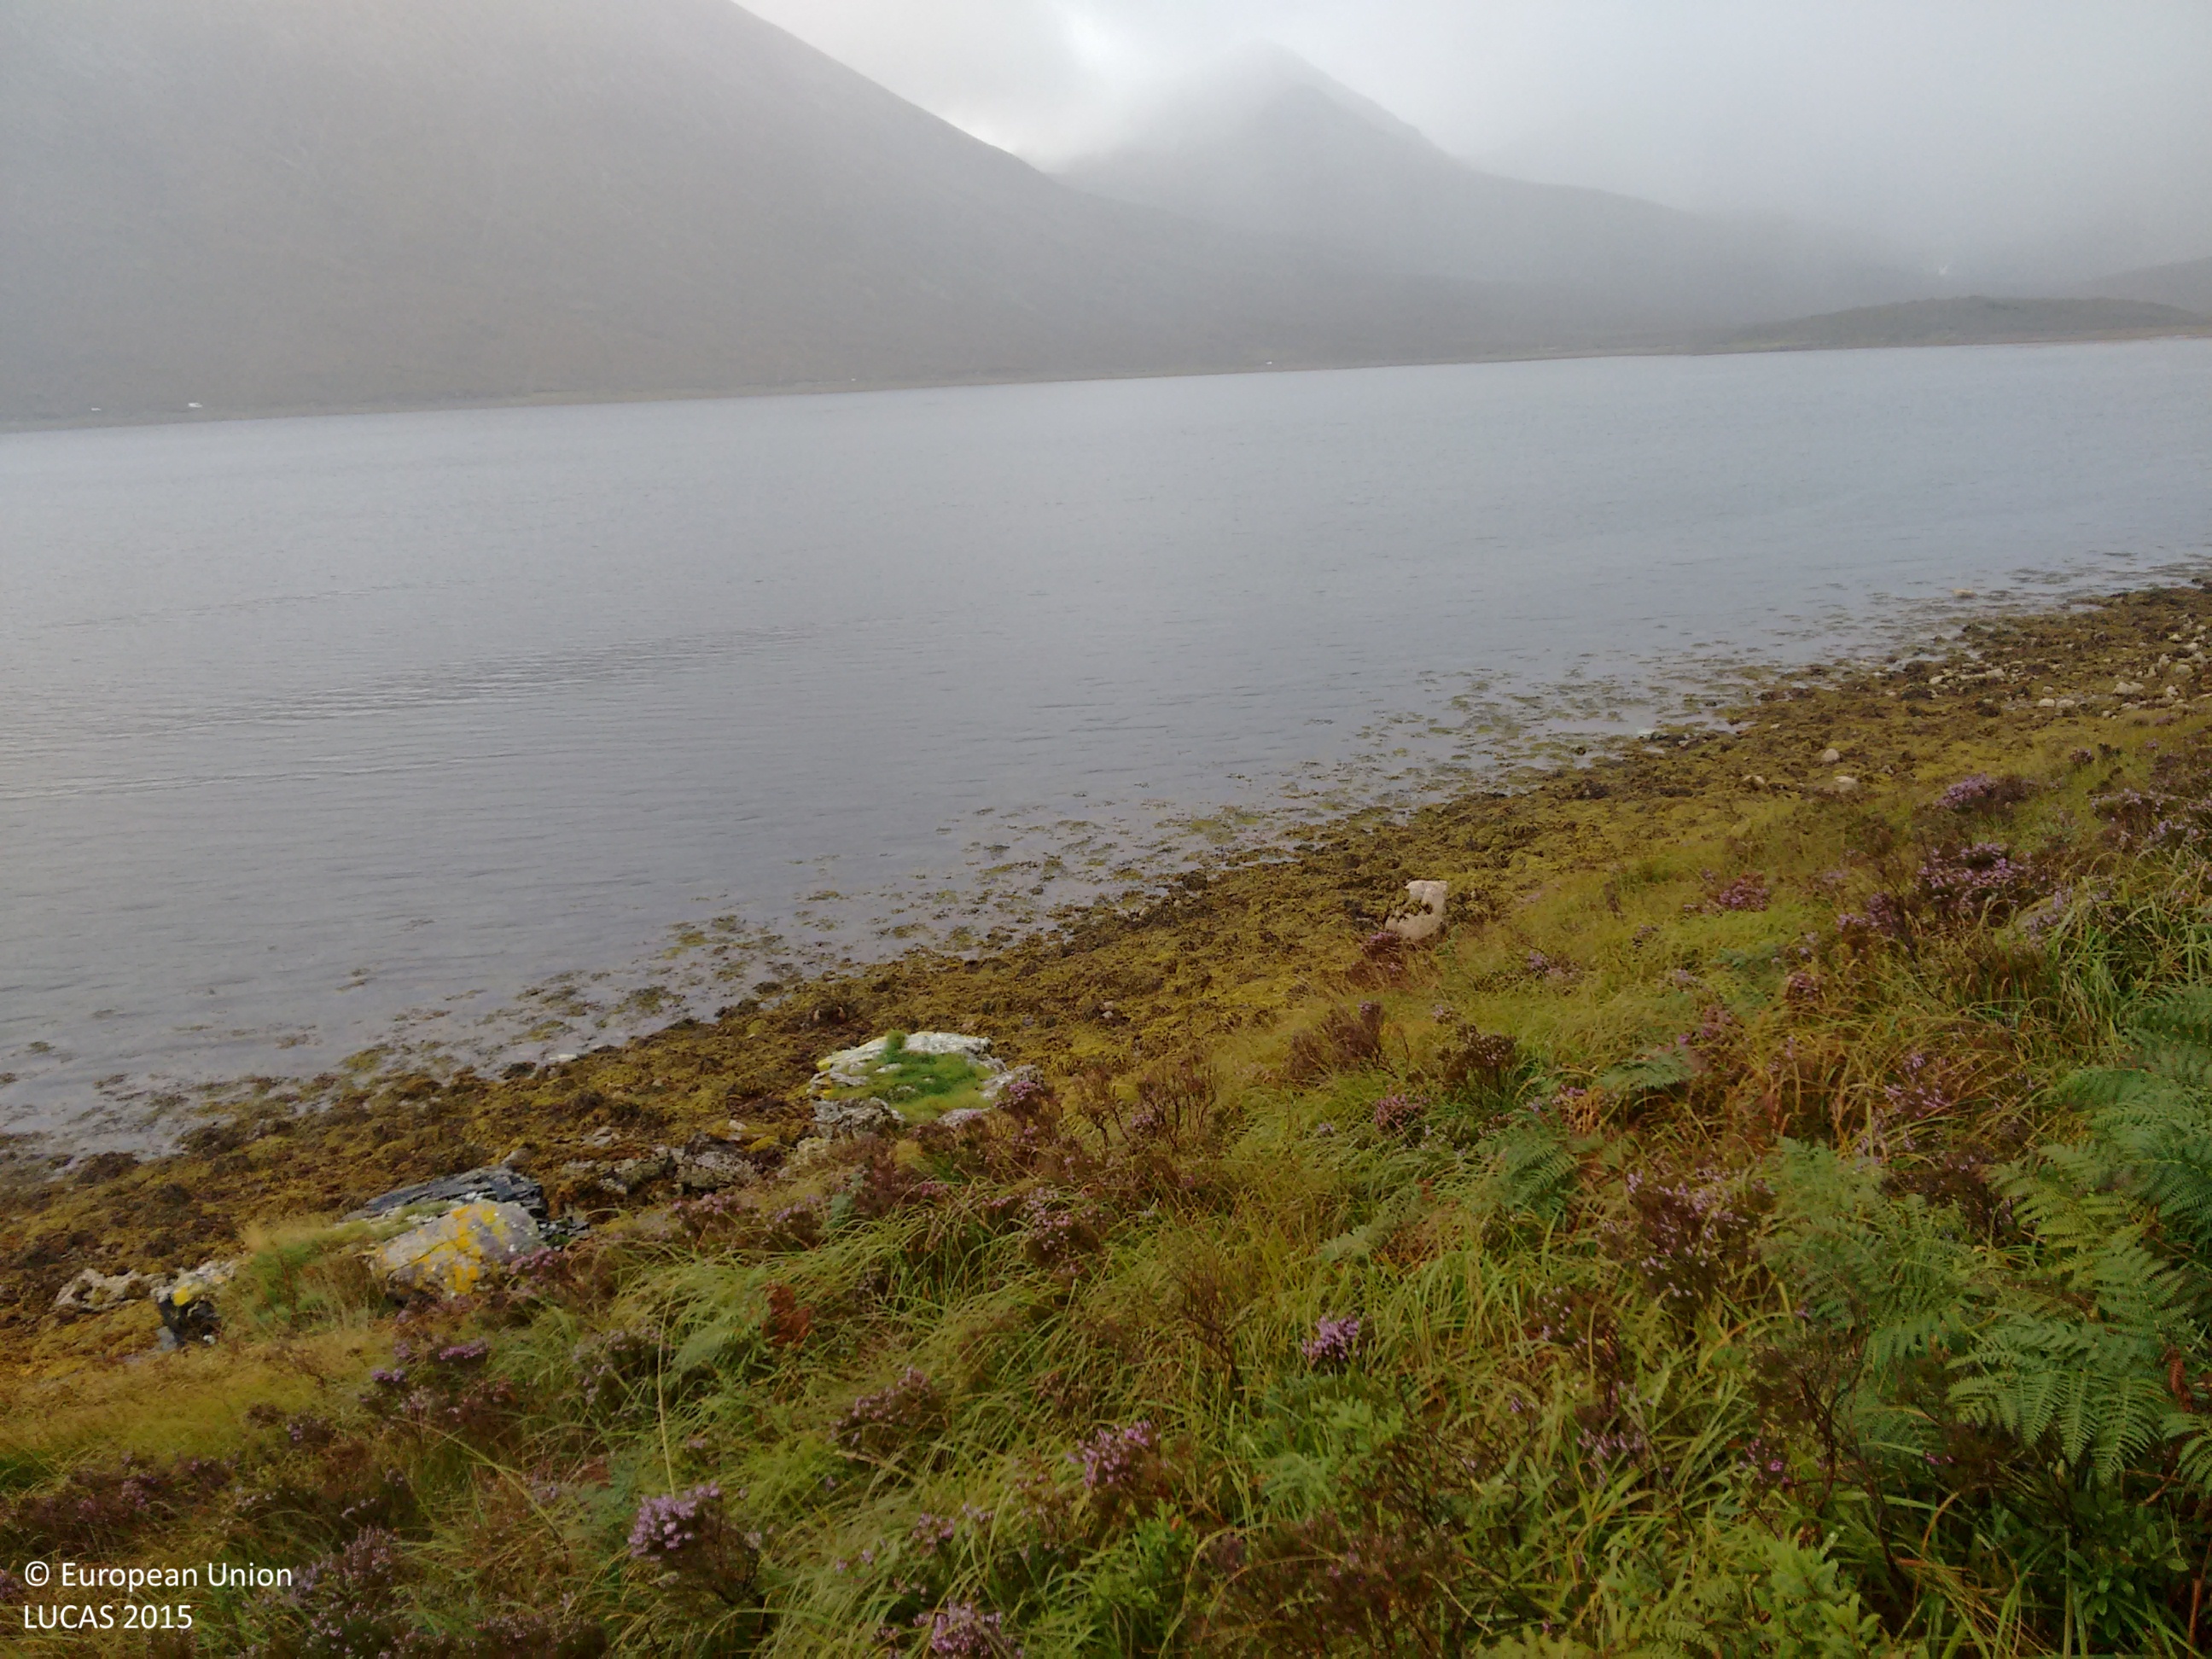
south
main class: Shrubland
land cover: Shrubland without tree cover
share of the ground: 50 - 75 %
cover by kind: shrubs 60 %, herbaceous plants 40 %
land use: Semi-natural and natural areas not in use
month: September
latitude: 57.2792
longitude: -6.0718
